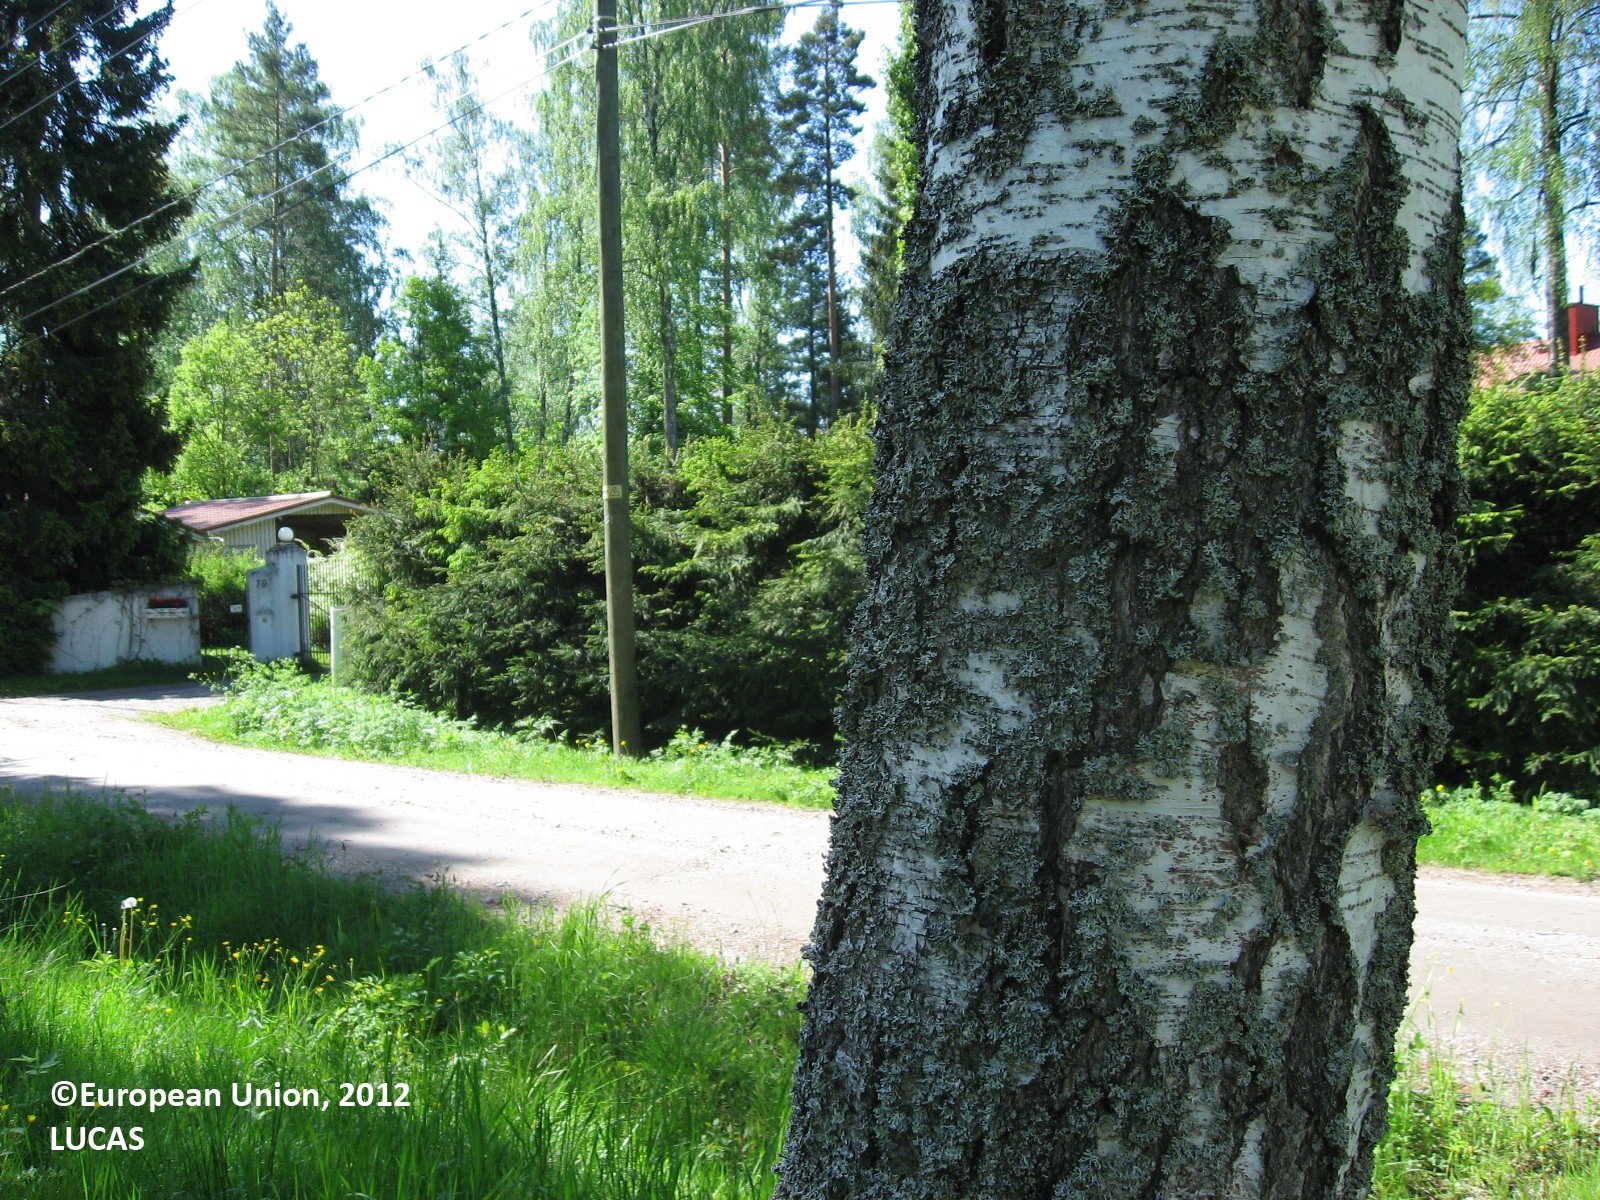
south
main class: Woodland
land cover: Broadleaved woodland
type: boreal forest
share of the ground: > 75 %
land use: Forestry
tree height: > 5 m
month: June
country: FI
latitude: 60.3644
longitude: 25.3374
